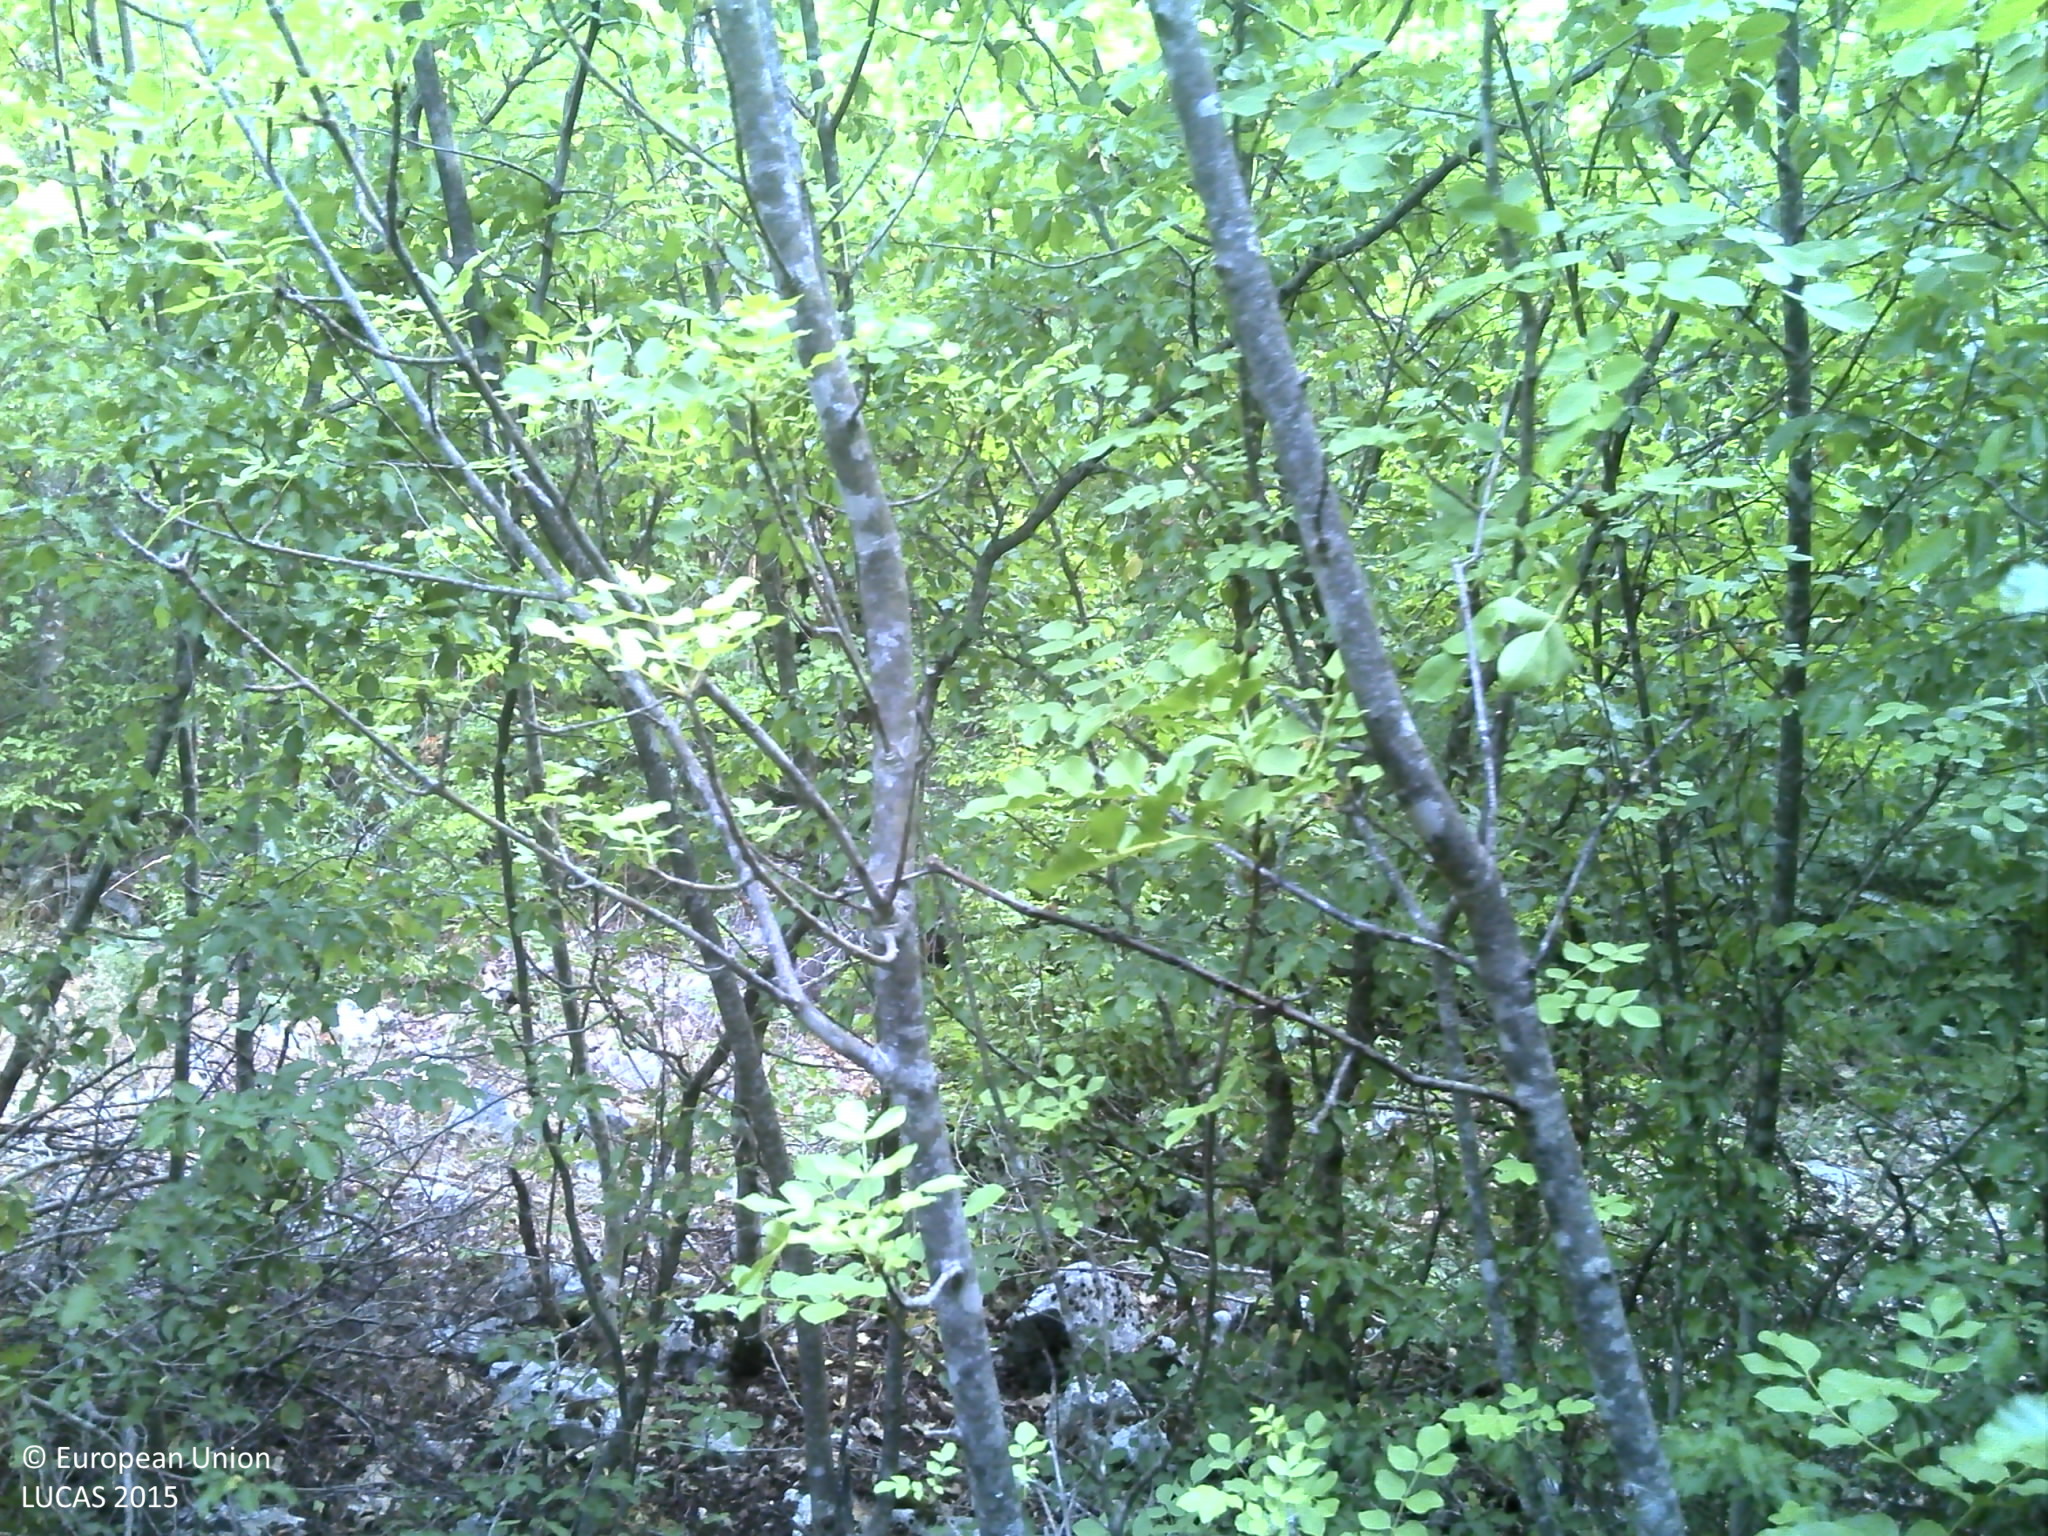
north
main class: Woodland
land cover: Other mixed woodland
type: thermophilous deciduous forest
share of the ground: > 75 %
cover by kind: broadleaved forest trees 55 %, coniferous forest trees 30 %, shrubs 10 %, consolidated bare surface 5 %
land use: Semi-natural and natural areas not in use
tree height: > 5 m
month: July
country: HR
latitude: 43.4511
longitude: 16.8991
